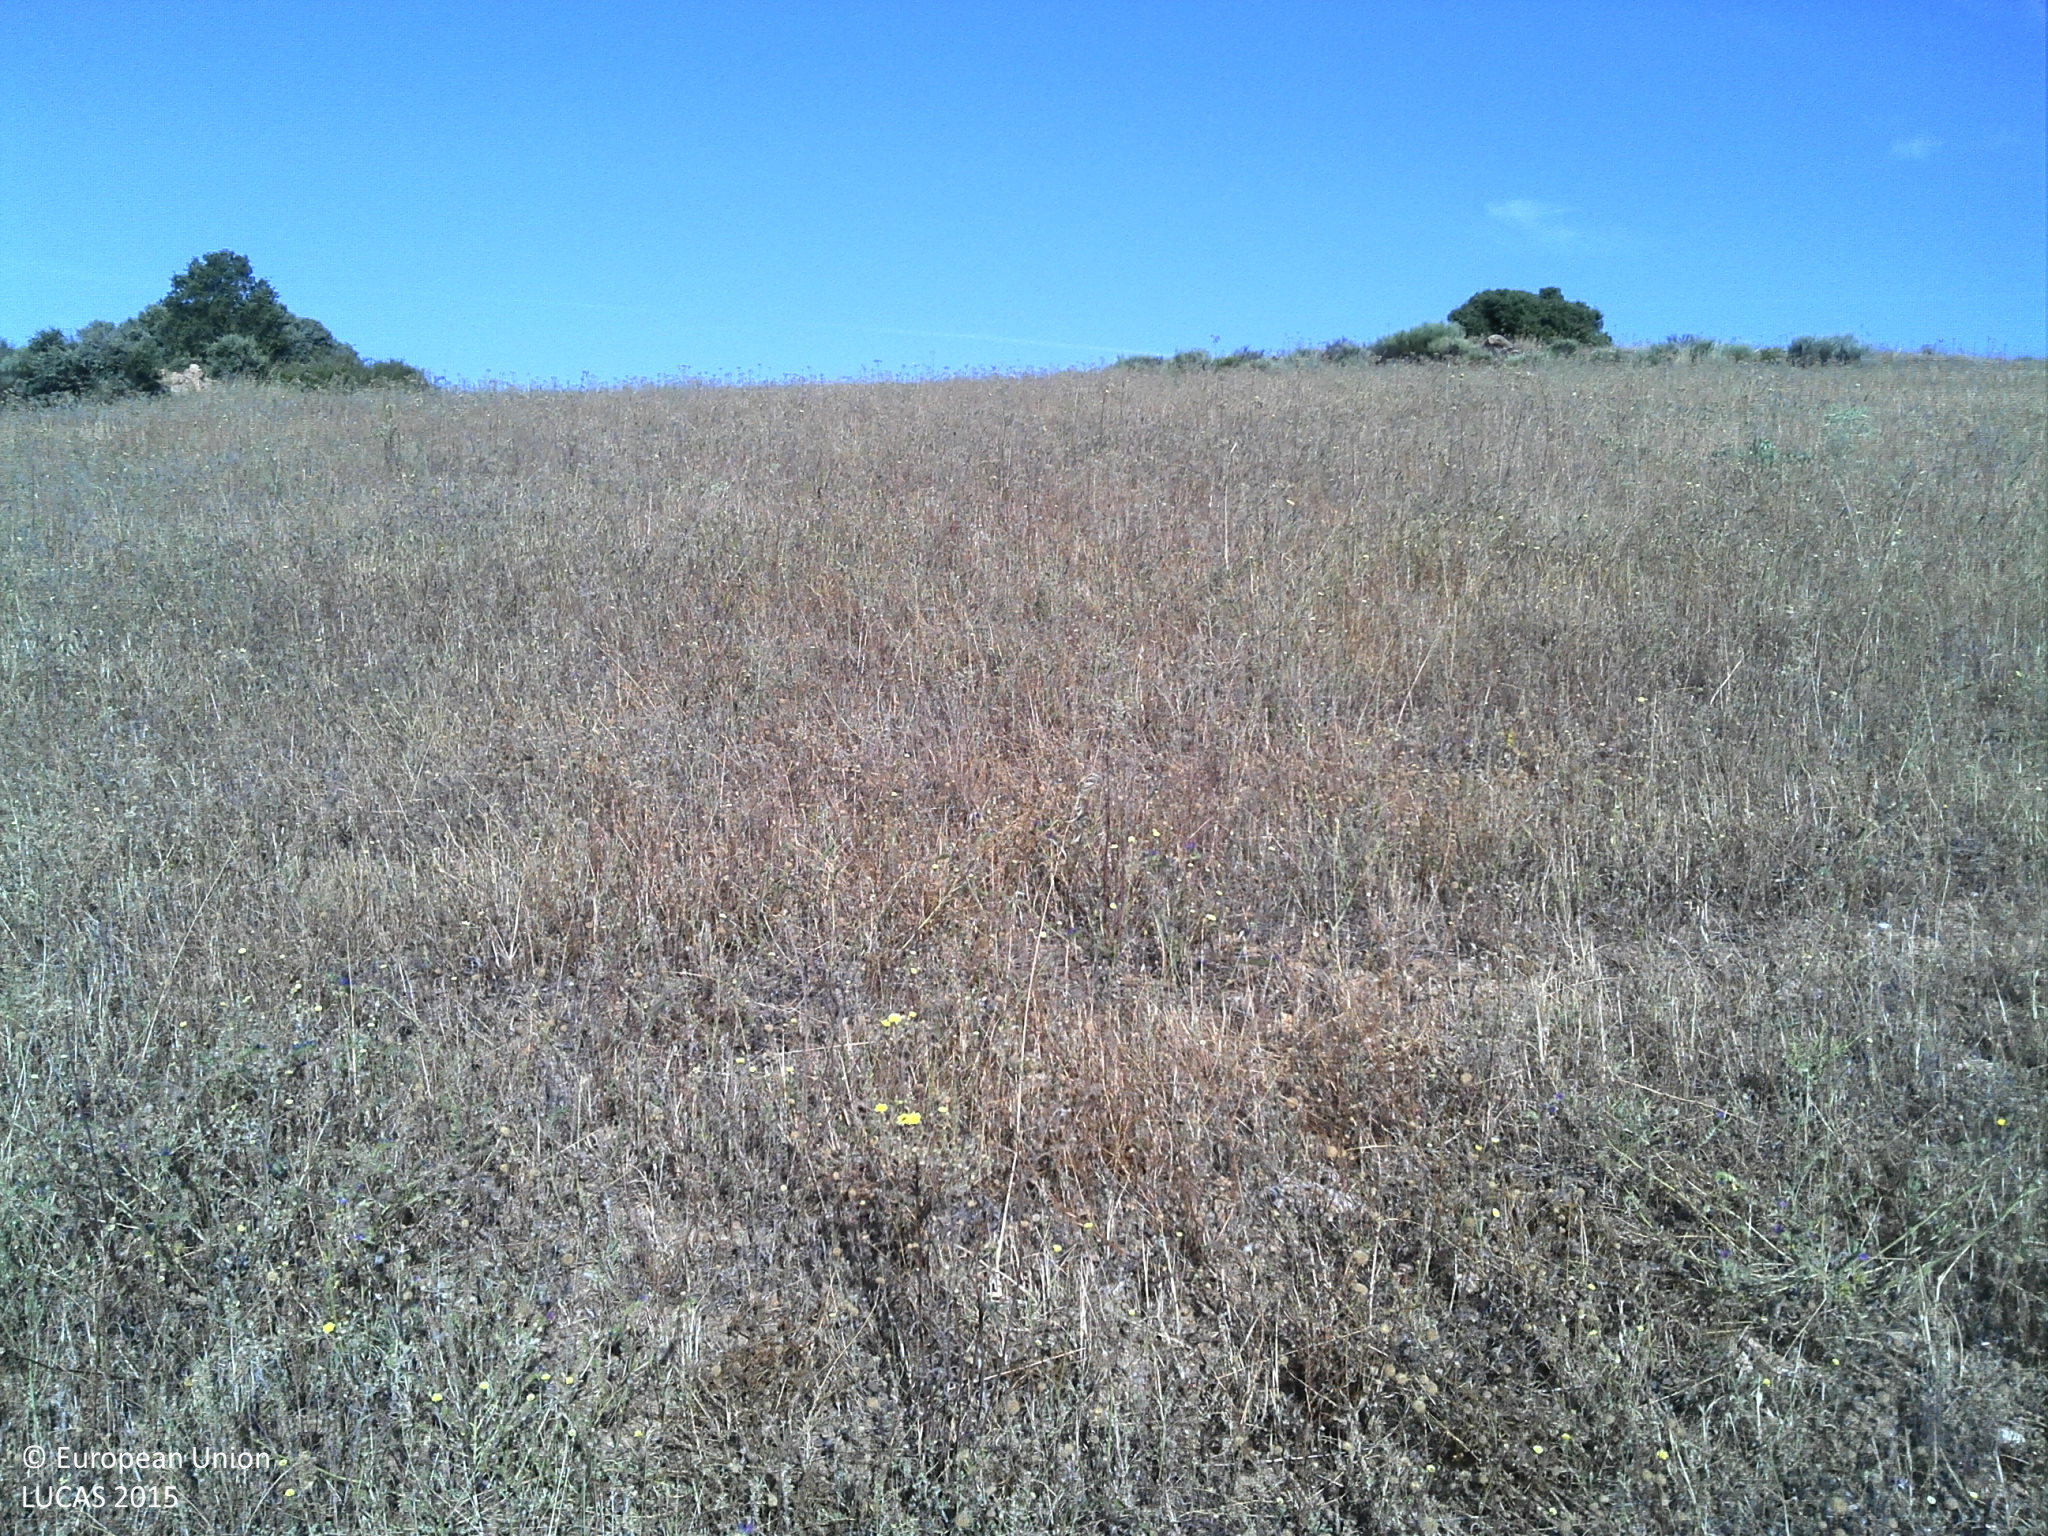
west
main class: Grassland
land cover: Spontaneously vegetated surfaces
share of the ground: > 75 %
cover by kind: herbaceous plants 95 %, unconsolidated bare surface 5 %
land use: Fallow land
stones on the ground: 10 - 25 %
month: June
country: PT
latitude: 40.8772
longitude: -6.8692
